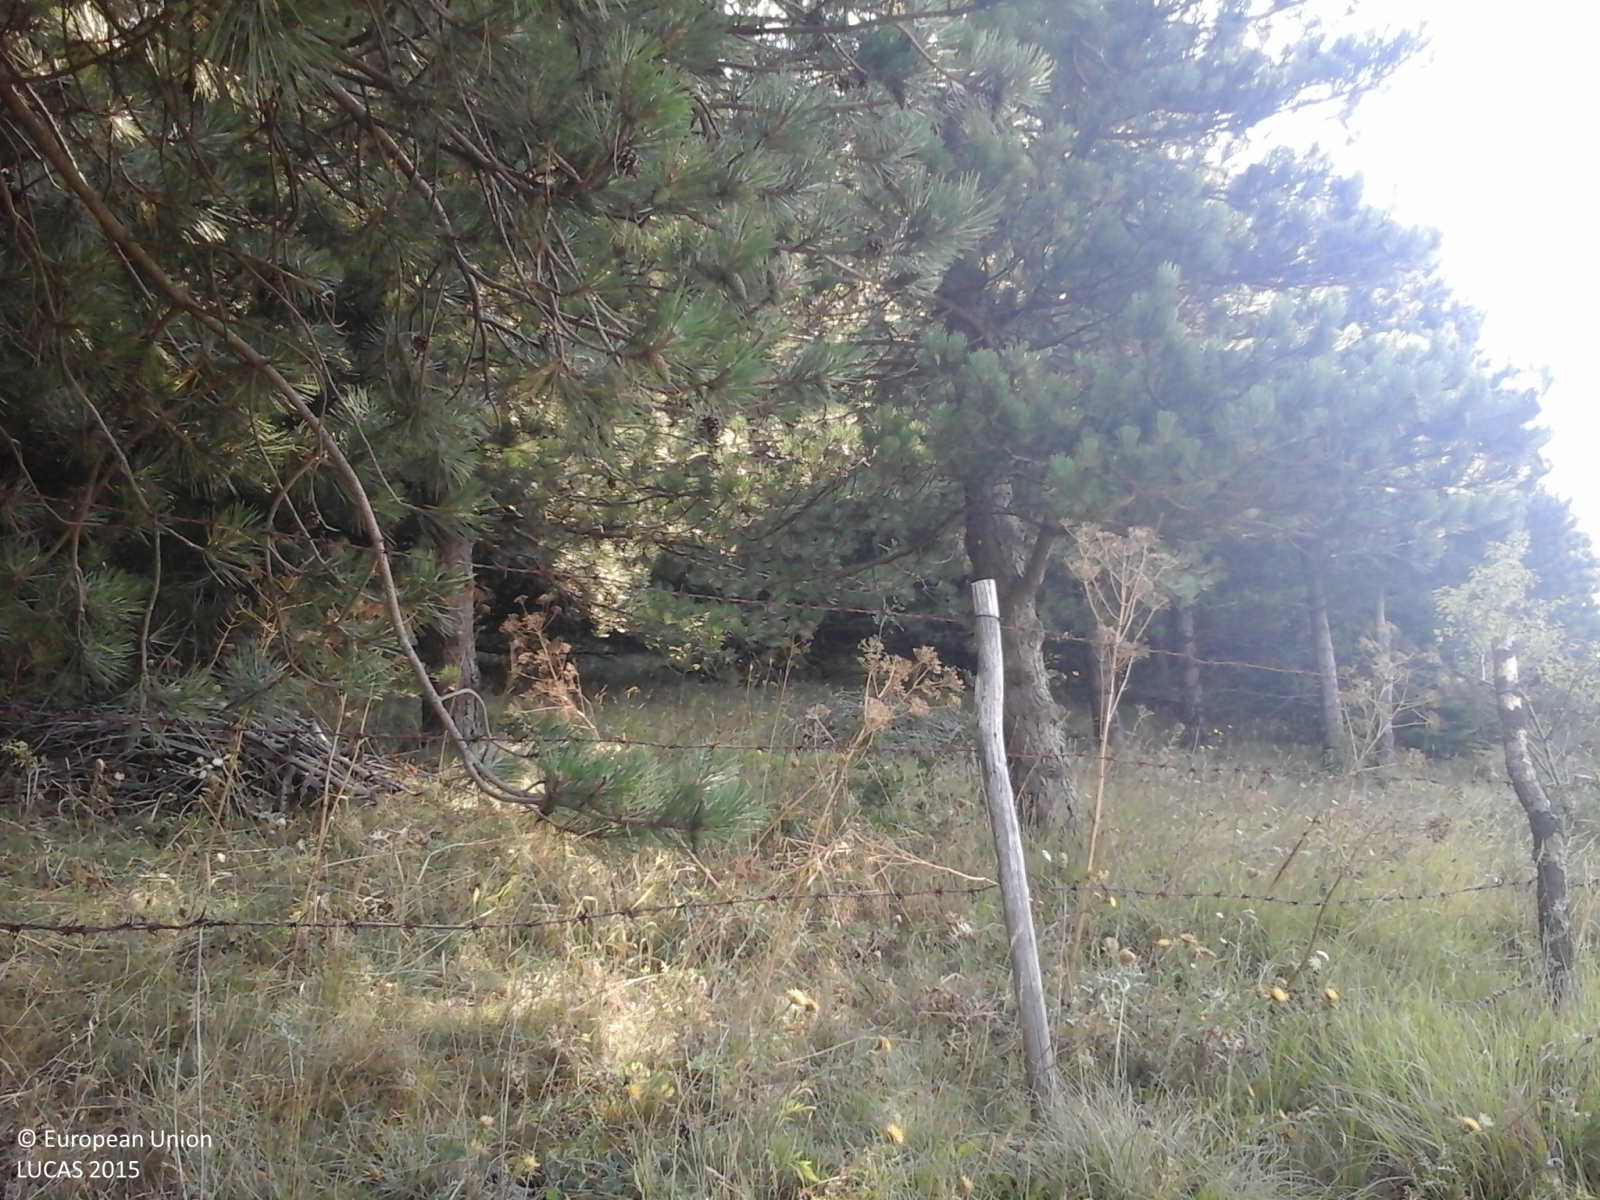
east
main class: Woodland
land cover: Pine dominated coniferous woodland
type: coniferous forest of the mediterranean region
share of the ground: > 75 %
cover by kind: coniferous forest trees 95 %, herbaceous plants 5 %
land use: Semi-natural and natural areas not in use
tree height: > 5 m
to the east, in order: Pine dominated coniferous woodland
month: August
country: IT
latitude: 41.3652
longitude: 15.1346
